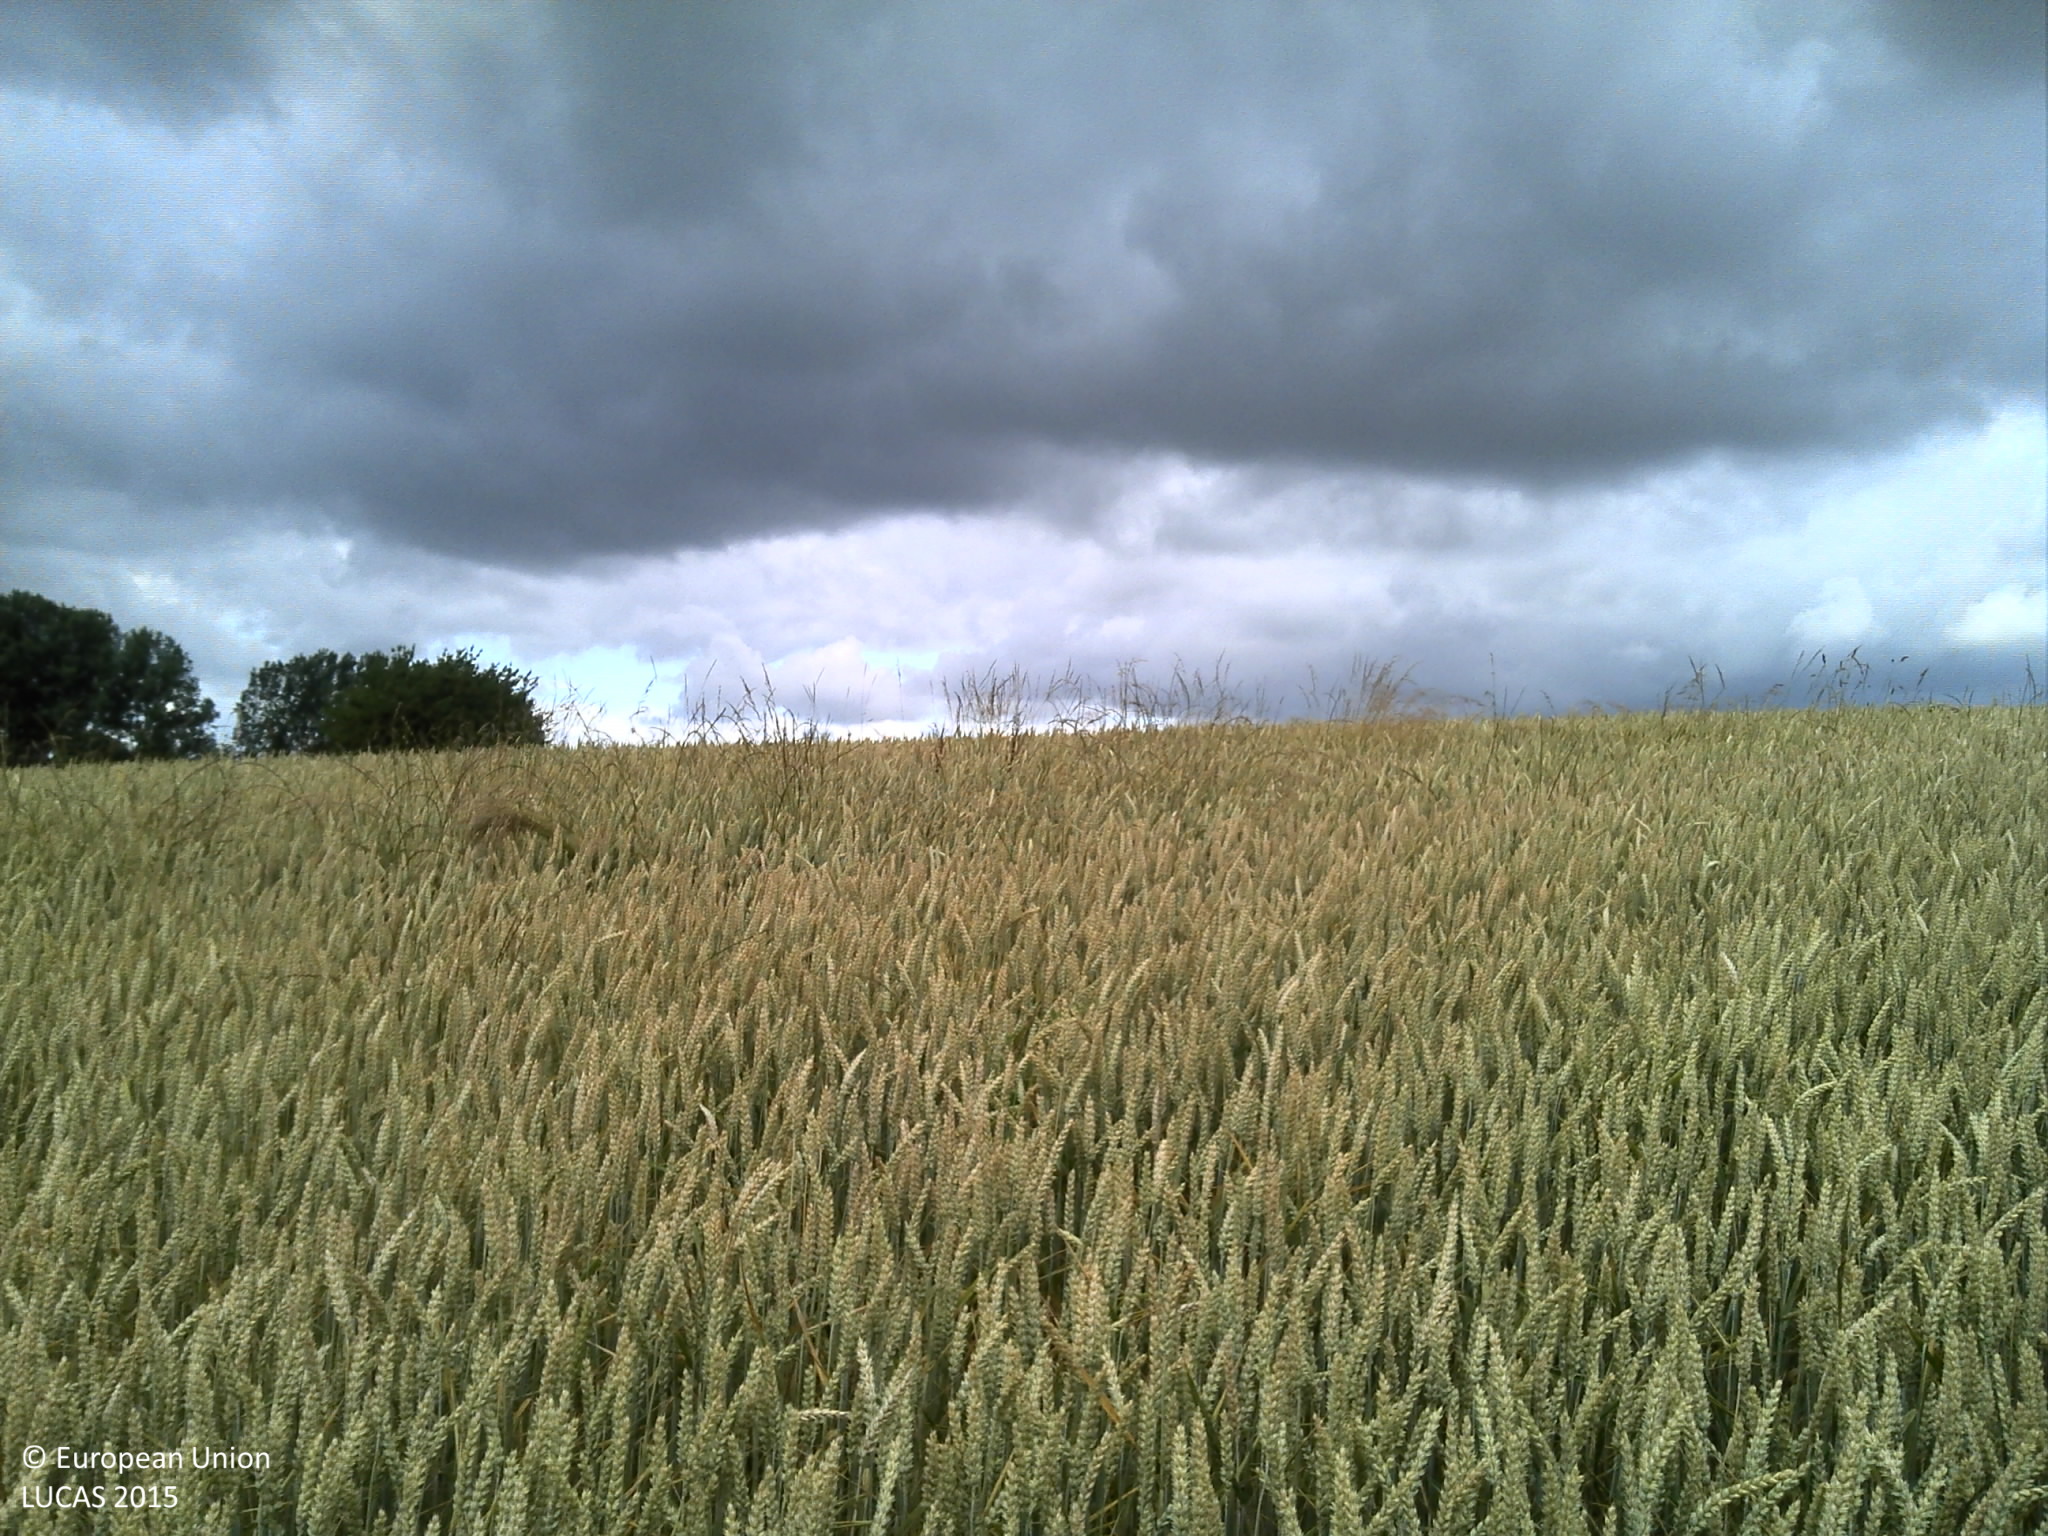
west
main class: Cropland
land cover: Common wheat
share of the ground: > 75 %
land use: Agriculture (excluding fallow land and kitchen gardens)
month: July
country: FR
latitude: 49.8062
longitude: 4.6469
